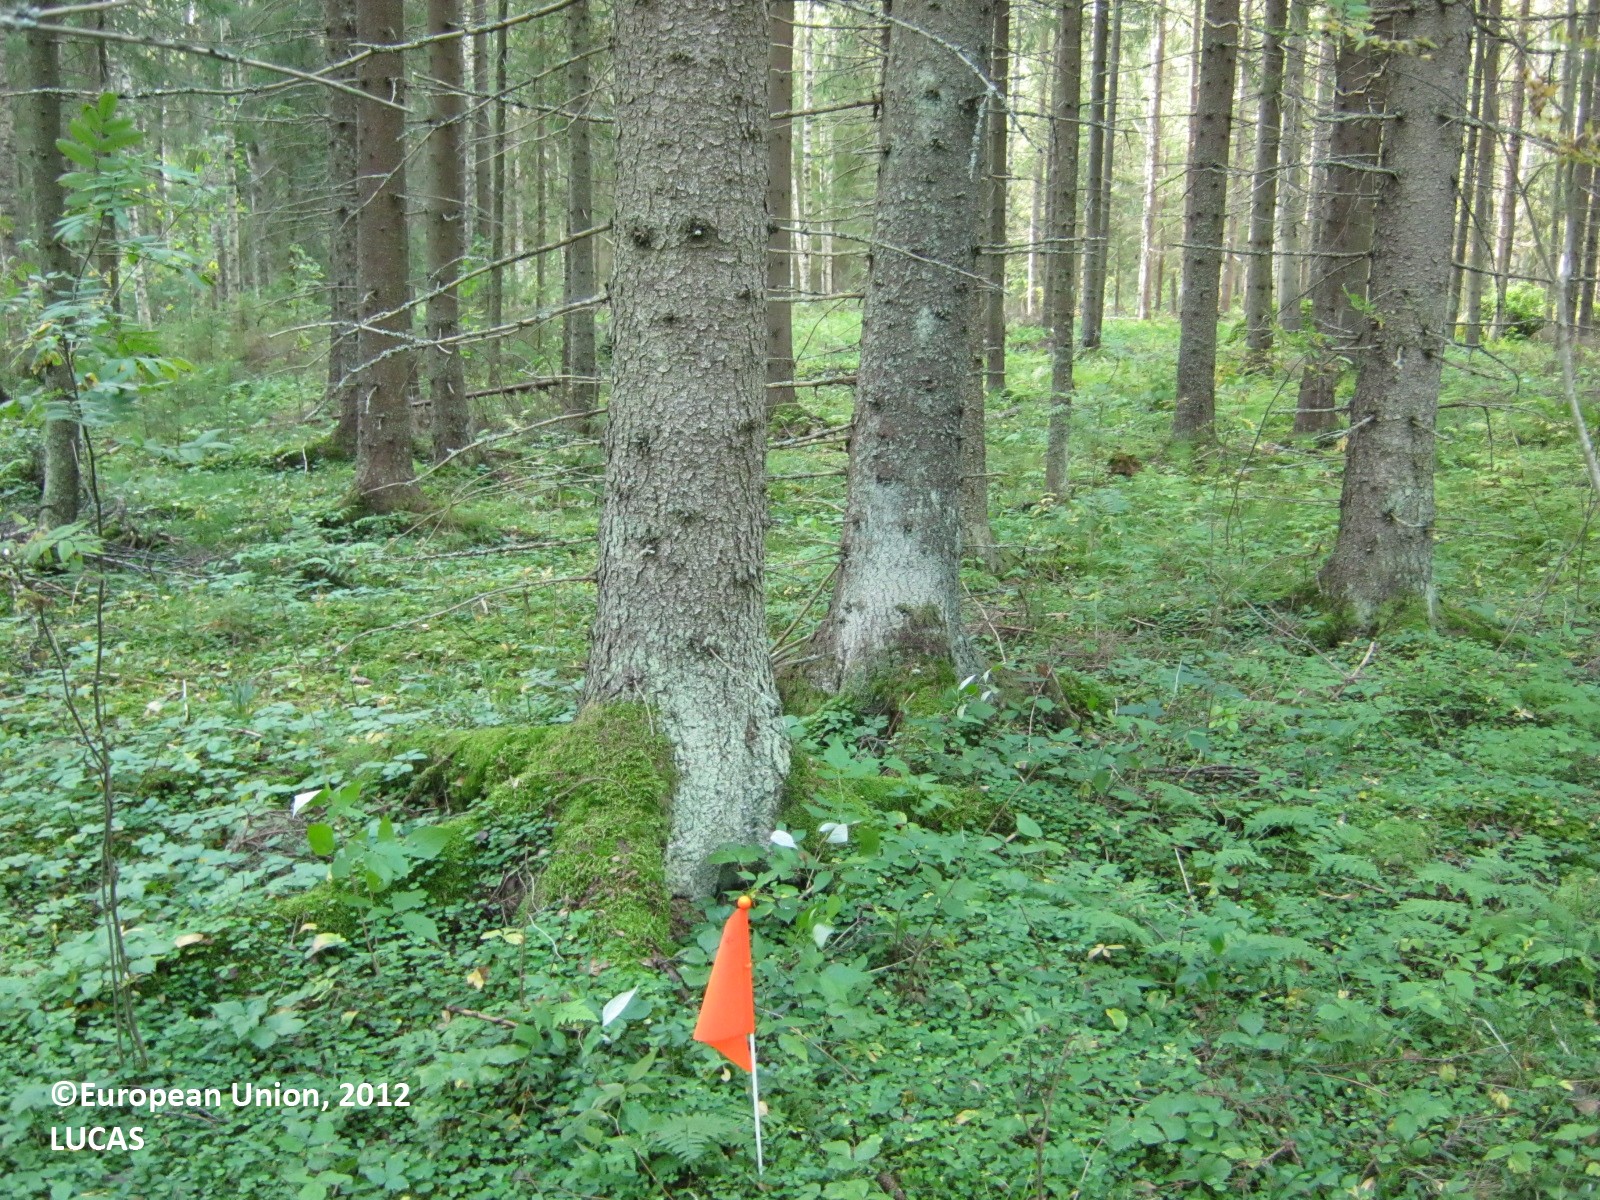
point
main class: Woodland
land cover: Other coniferous woodland
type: boreal forest
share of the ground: 50 - 75 %
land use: Forestry
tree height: > 5 m
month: September
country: FI
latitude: 60.9234
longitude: 27.8095
